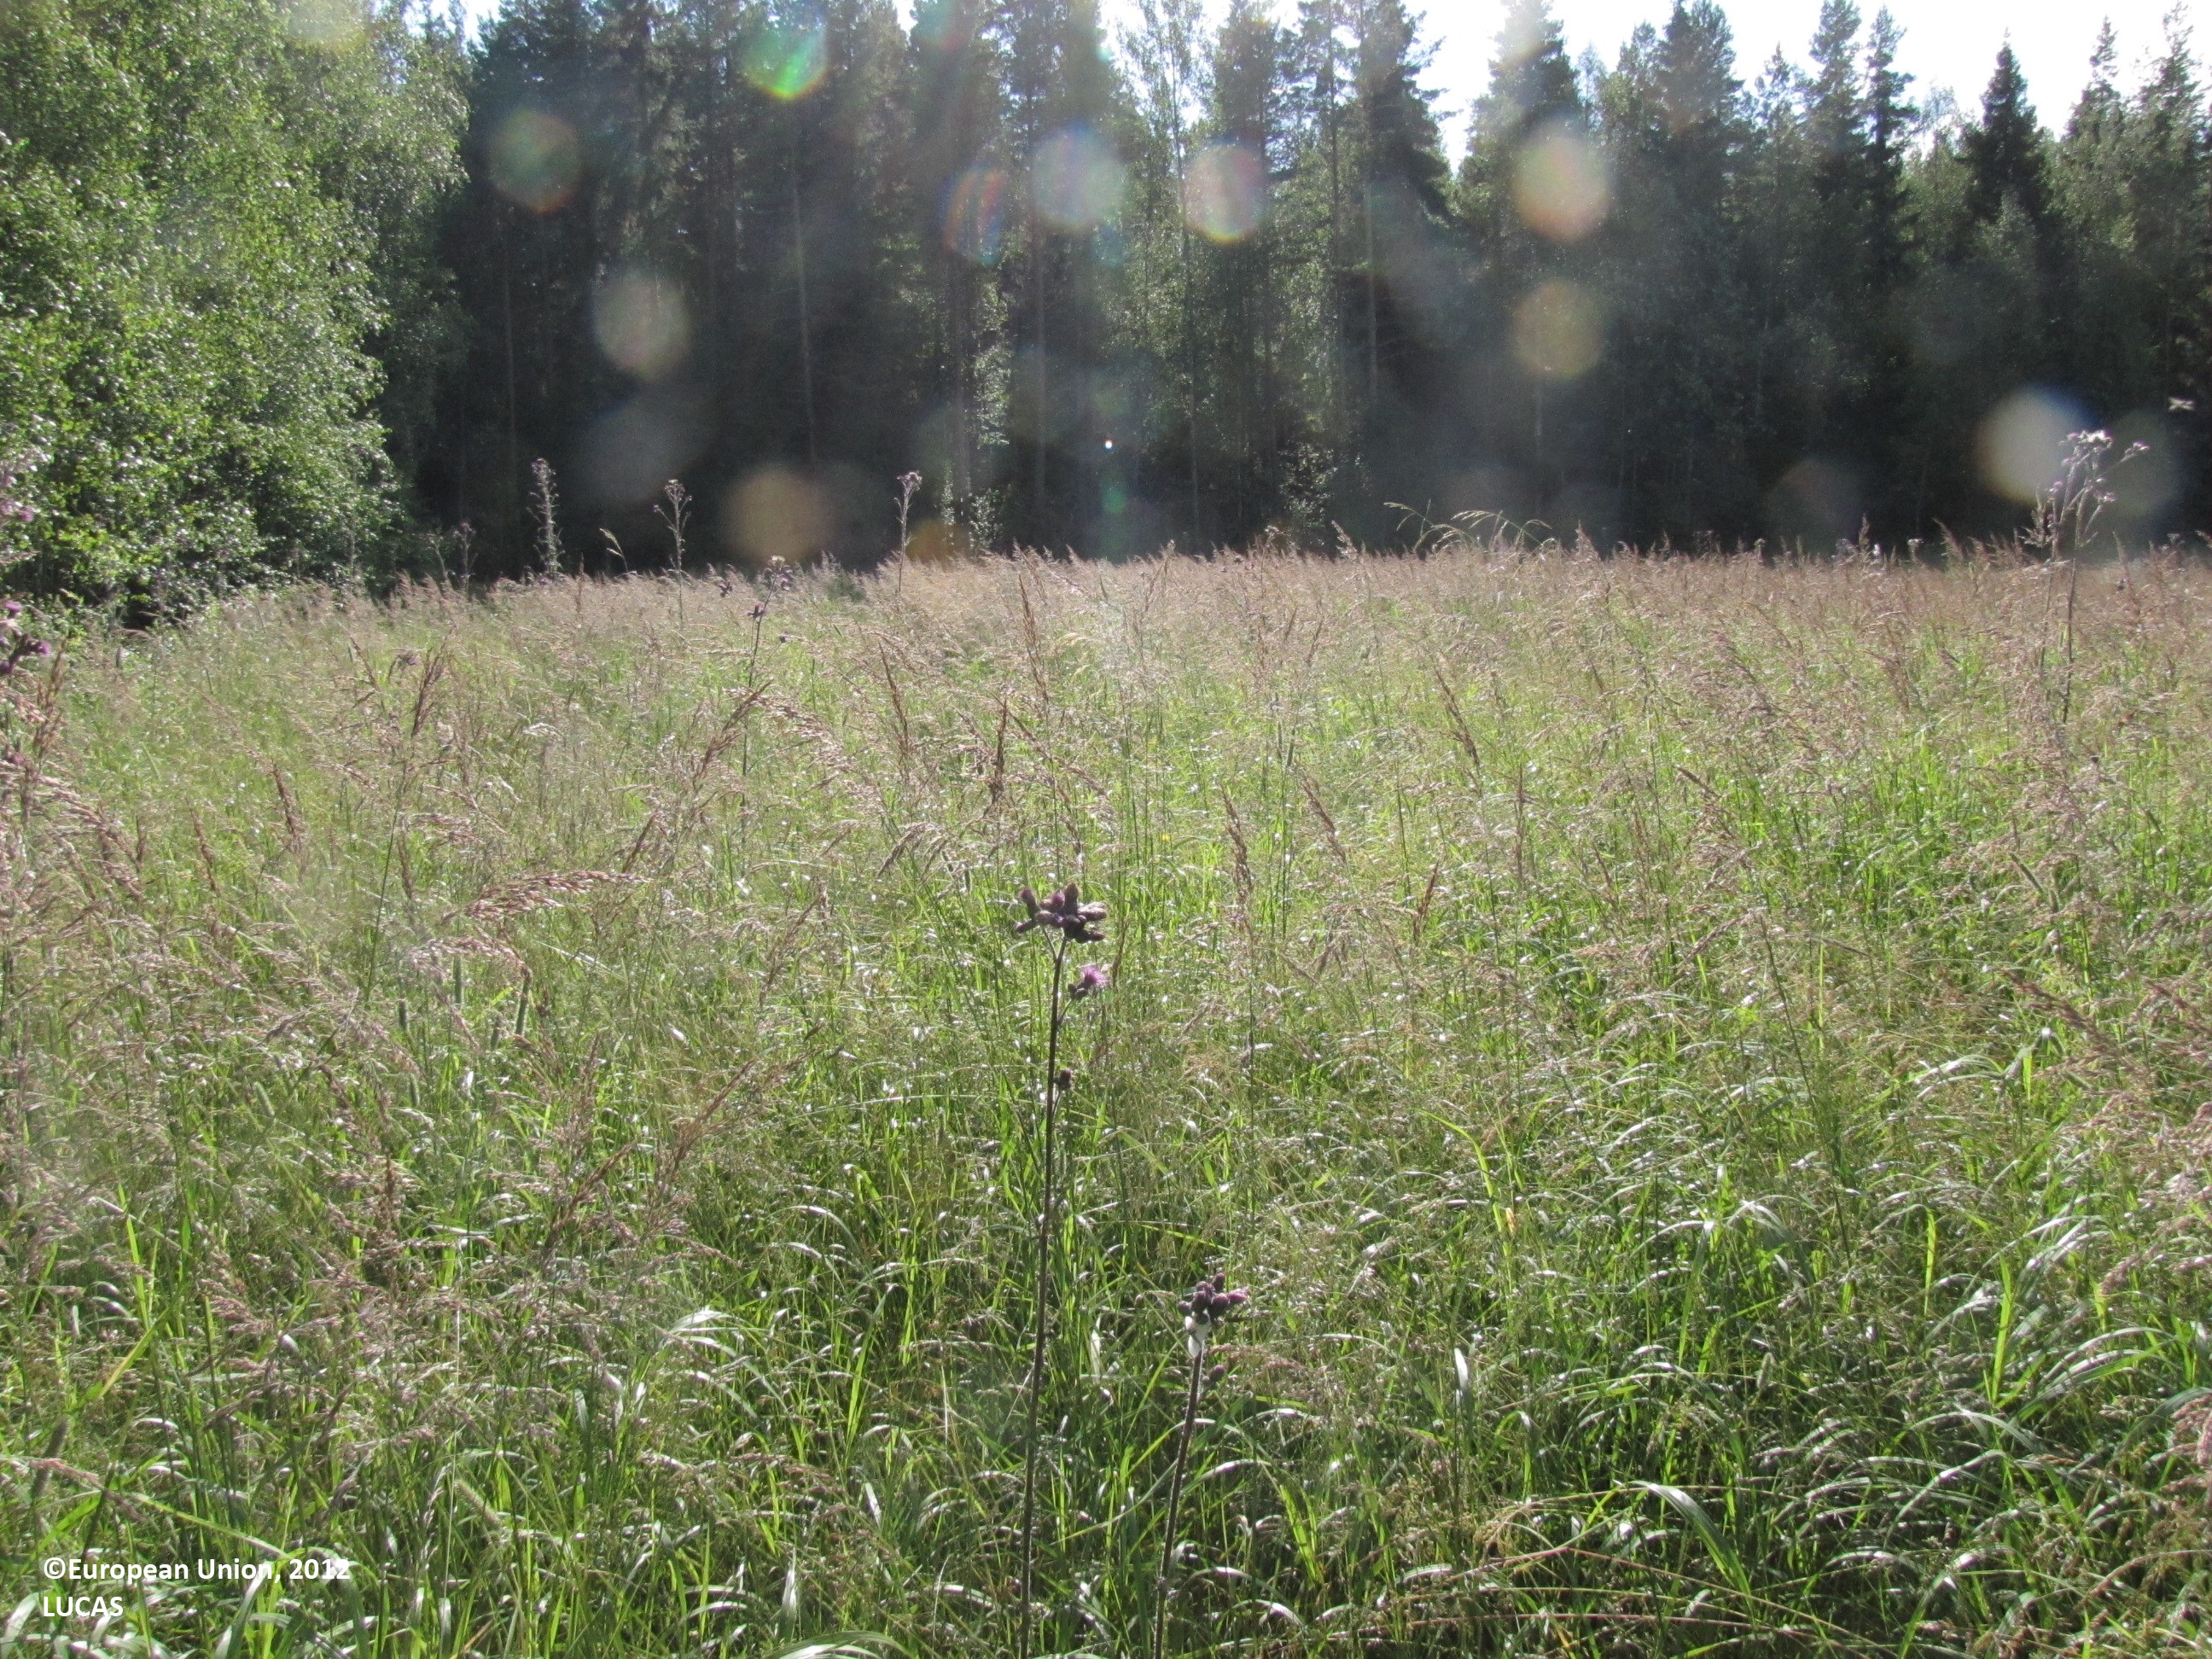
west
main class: Grassland
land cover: Grassland without tree/shrub cover
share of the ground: > 75 %
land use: Fallow land
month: July
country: FI
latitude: 62.5356
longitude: 23.2637
